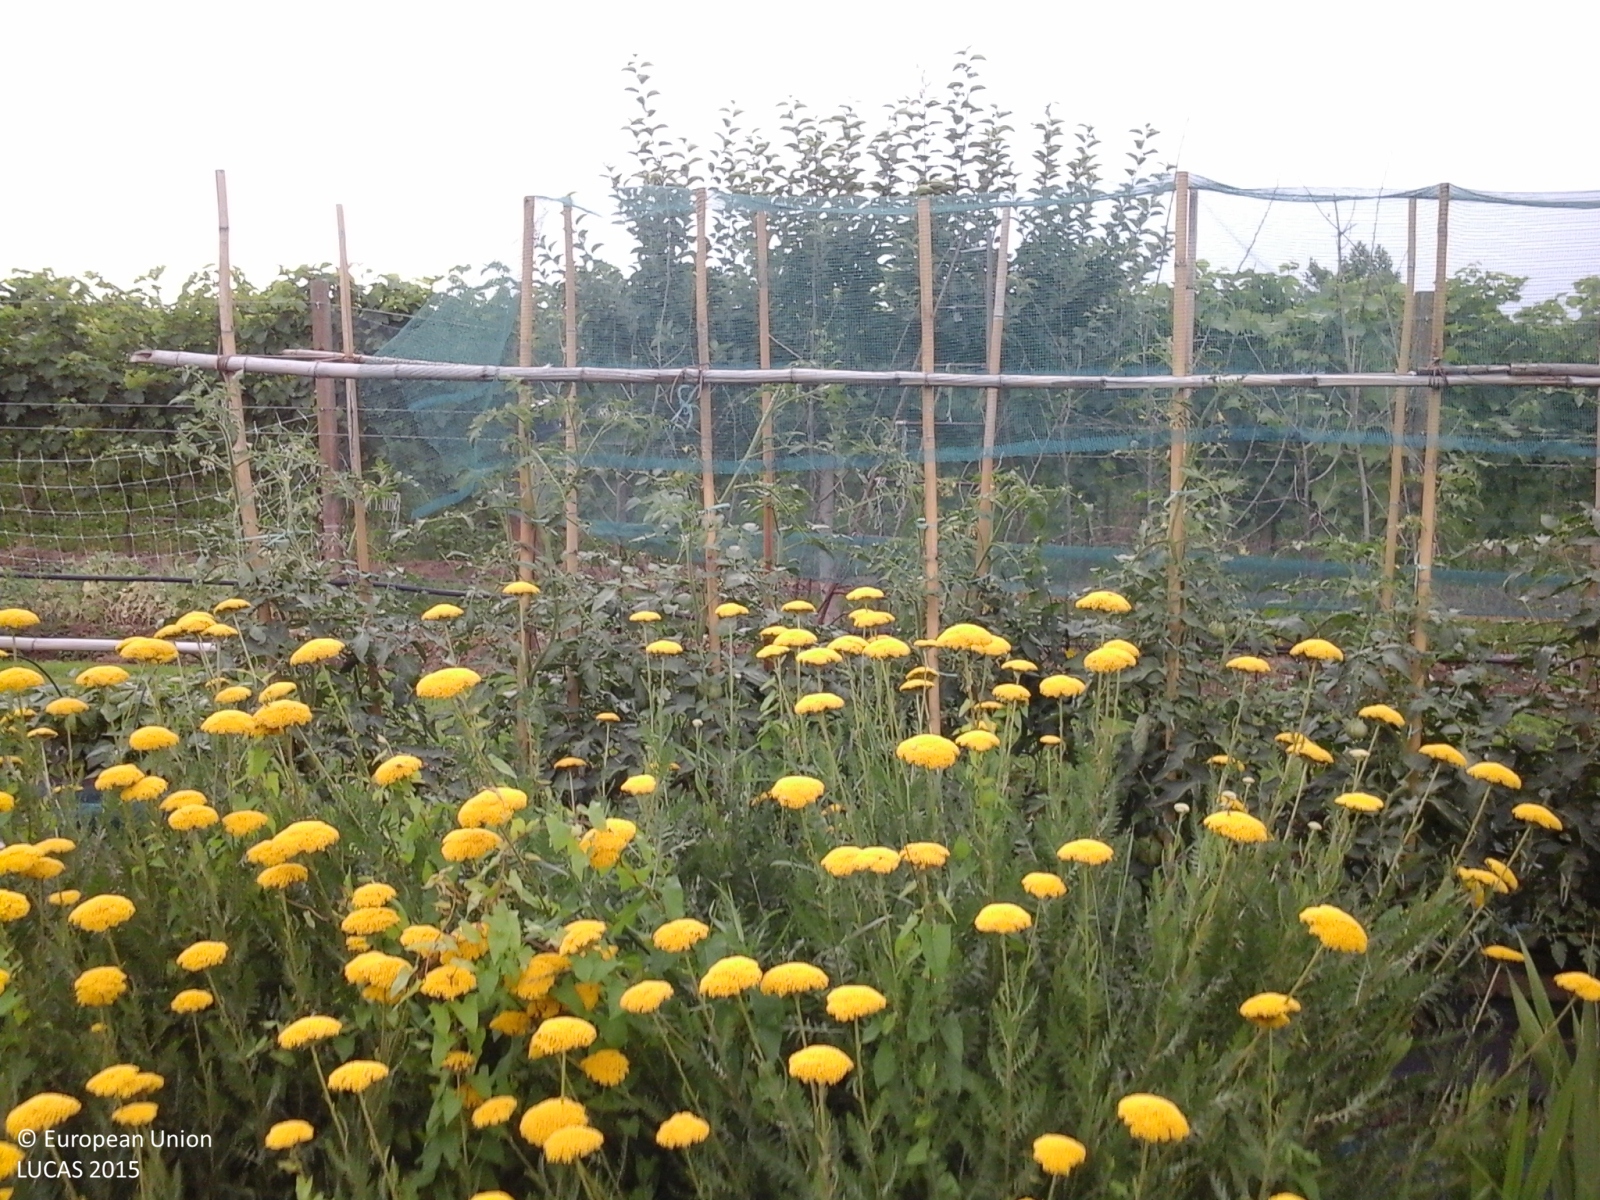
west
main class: Grassland
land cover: Grassland without tree/shrub cover
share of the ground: > 75 %
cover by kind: herbaceous plants 100 %
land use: Residential
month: June
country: IT
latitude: 45.8556
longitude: 12.4051
